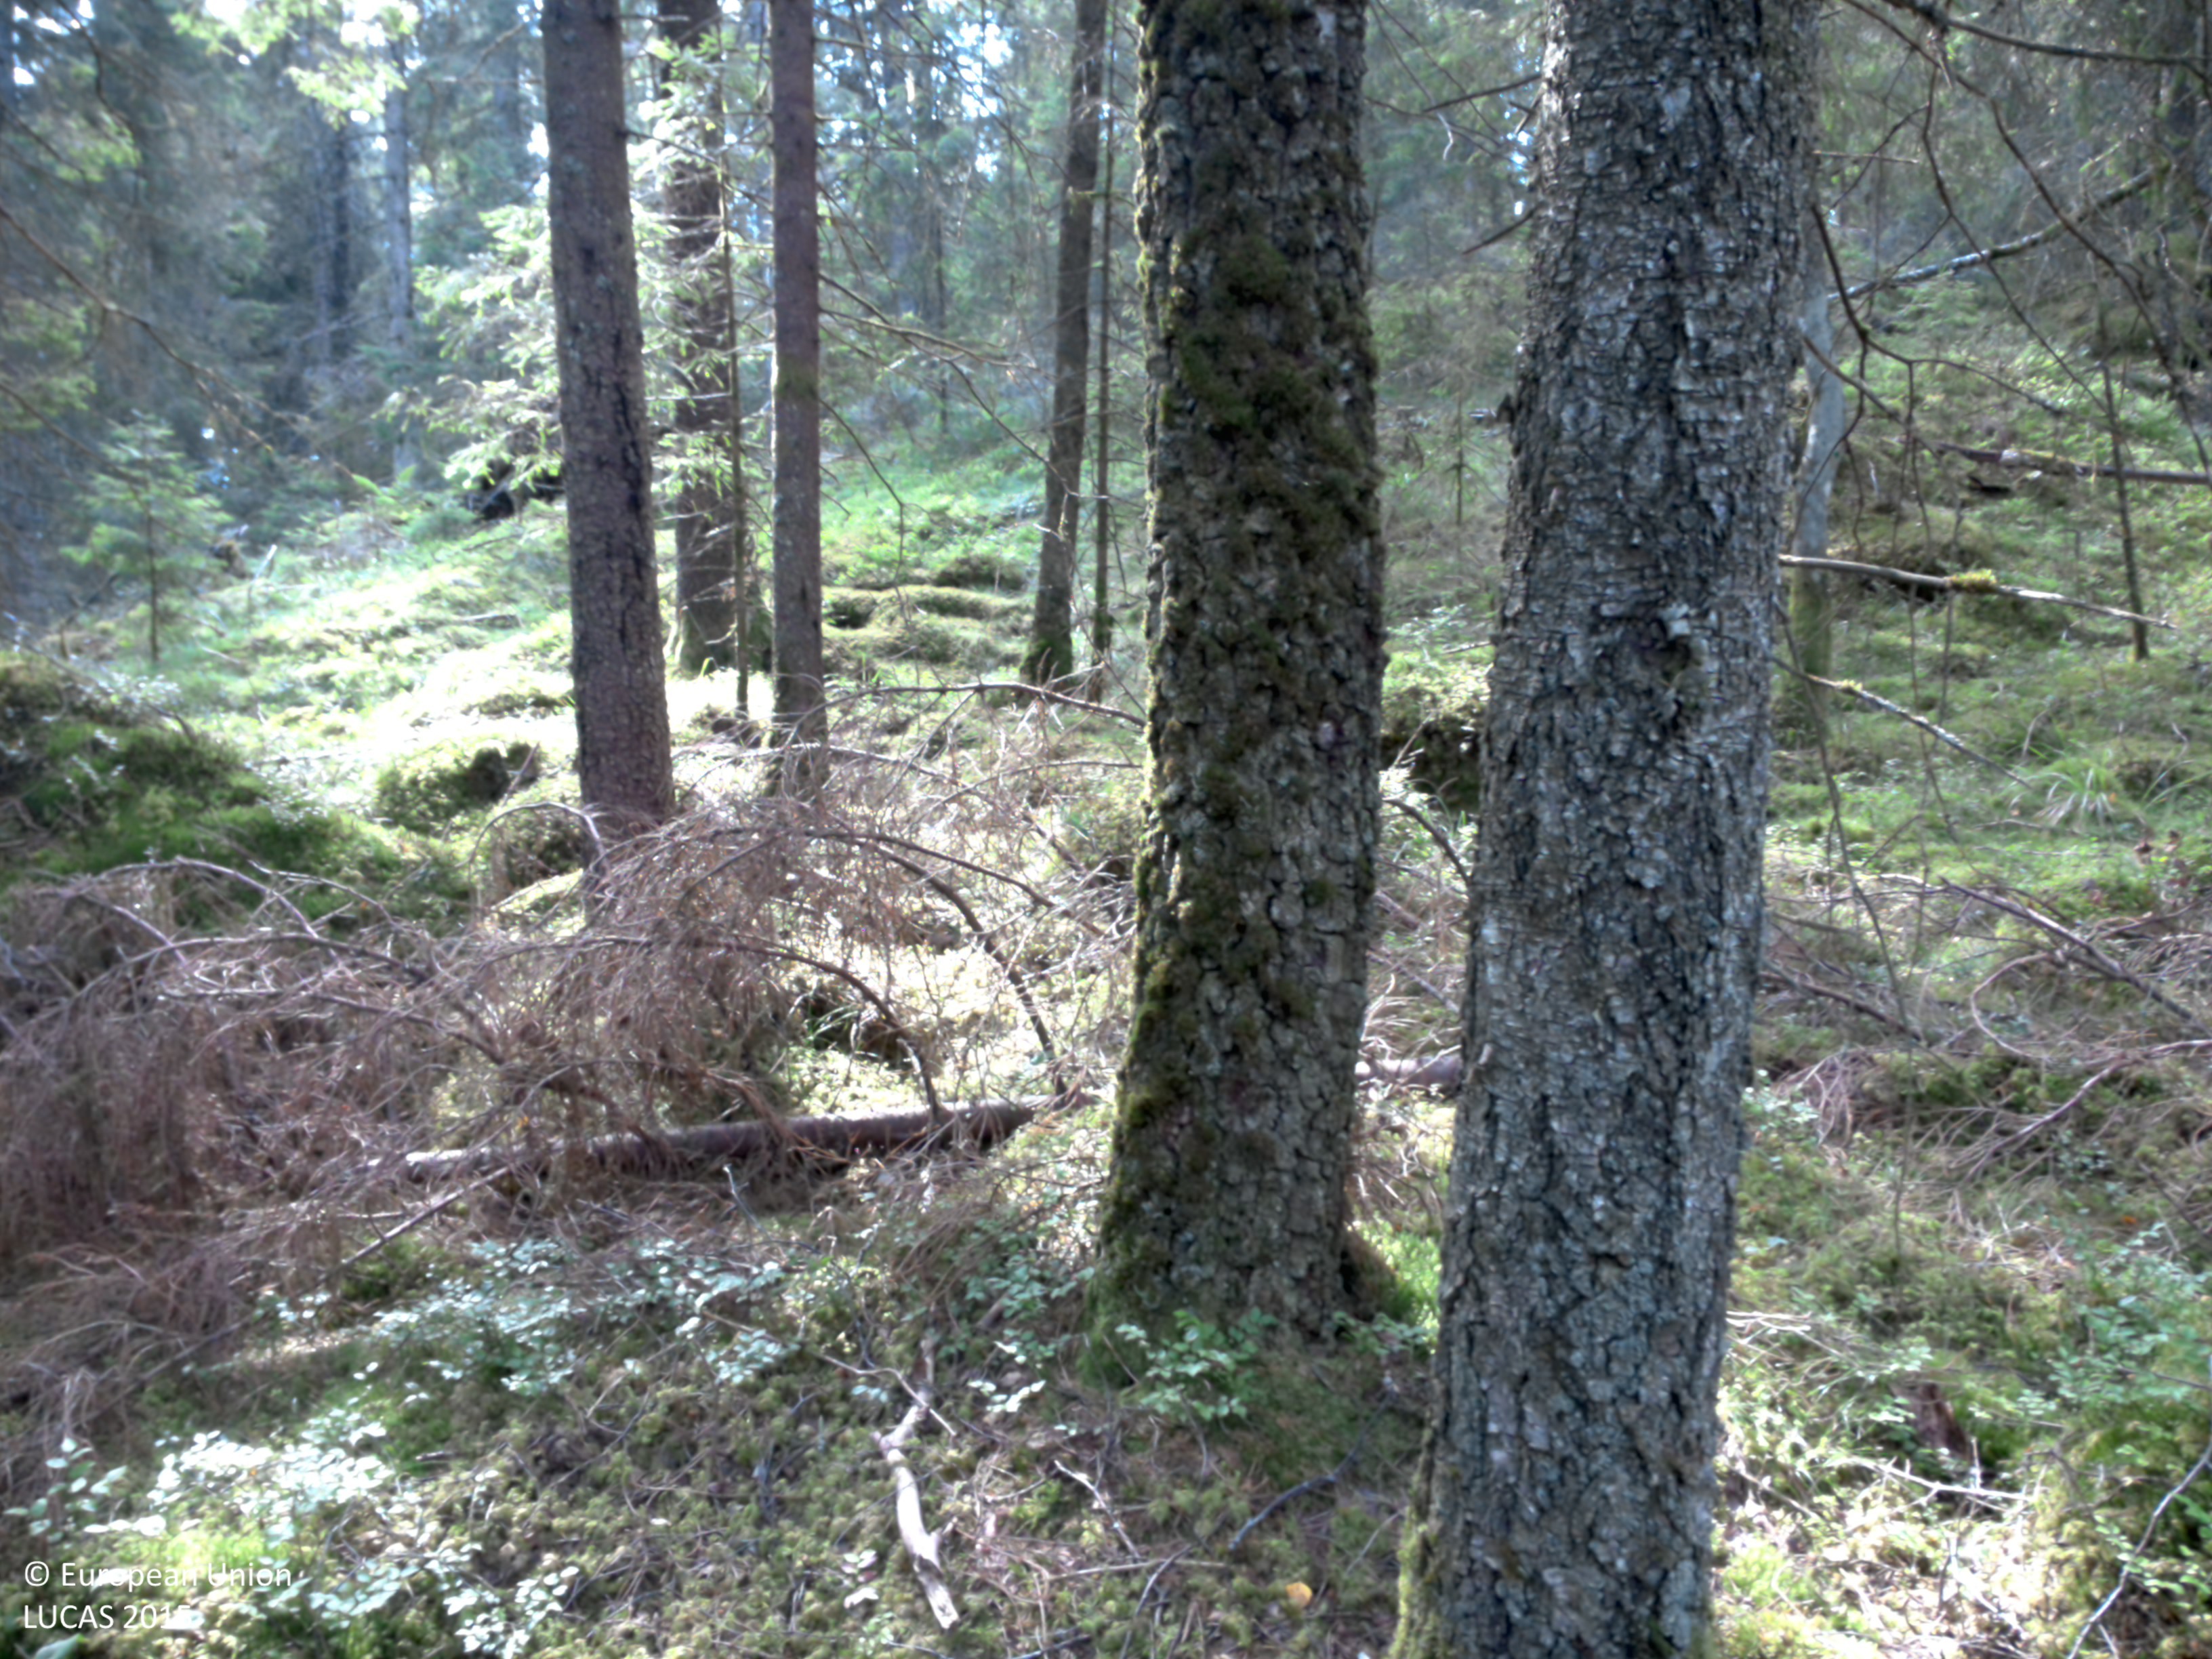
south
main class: Woodland
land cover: Spruce dominated coniferous woodland
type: boreal forest
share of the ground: 50 - 75 %
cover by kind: coniferous forest trees 60 %, lichens and mosses 30 %, shrubs 10 %
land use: Forestry
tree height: > 5 m
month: August
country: SE
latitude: 58.0017
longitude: 12.3140
